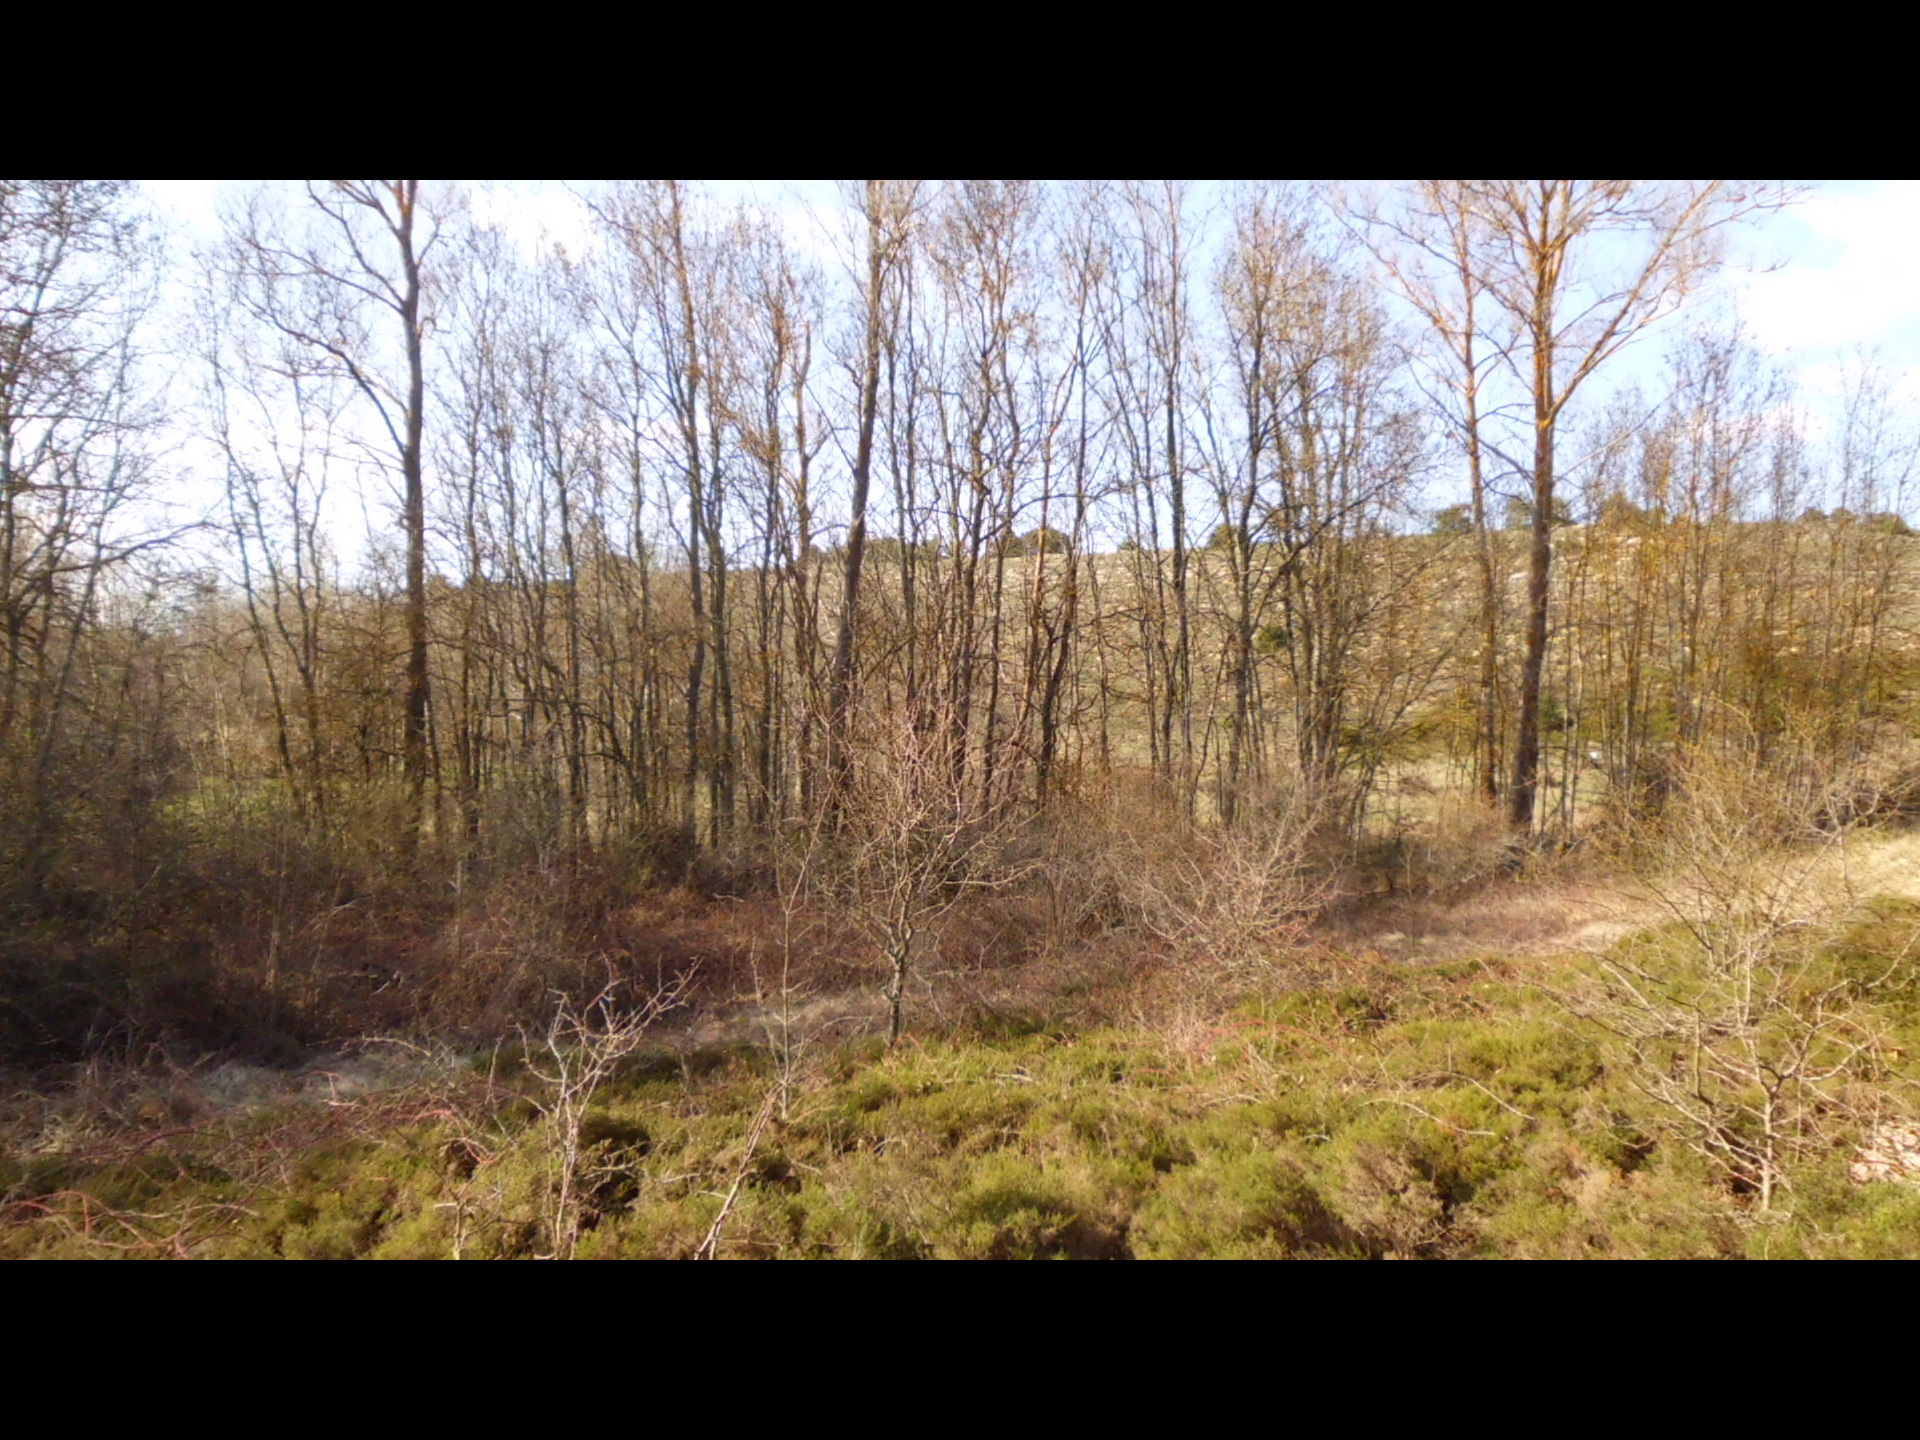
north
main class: Shrubland
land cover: Shrubland without tree cover
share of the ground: 50 - 75 %
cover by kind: herbaceous plants 65 %, shrubs 35 %
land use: Semi-natural and natural areas not in use
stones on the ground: 25 - 50 %
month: April
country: ES
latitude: 42.5927
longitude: -3.7247
